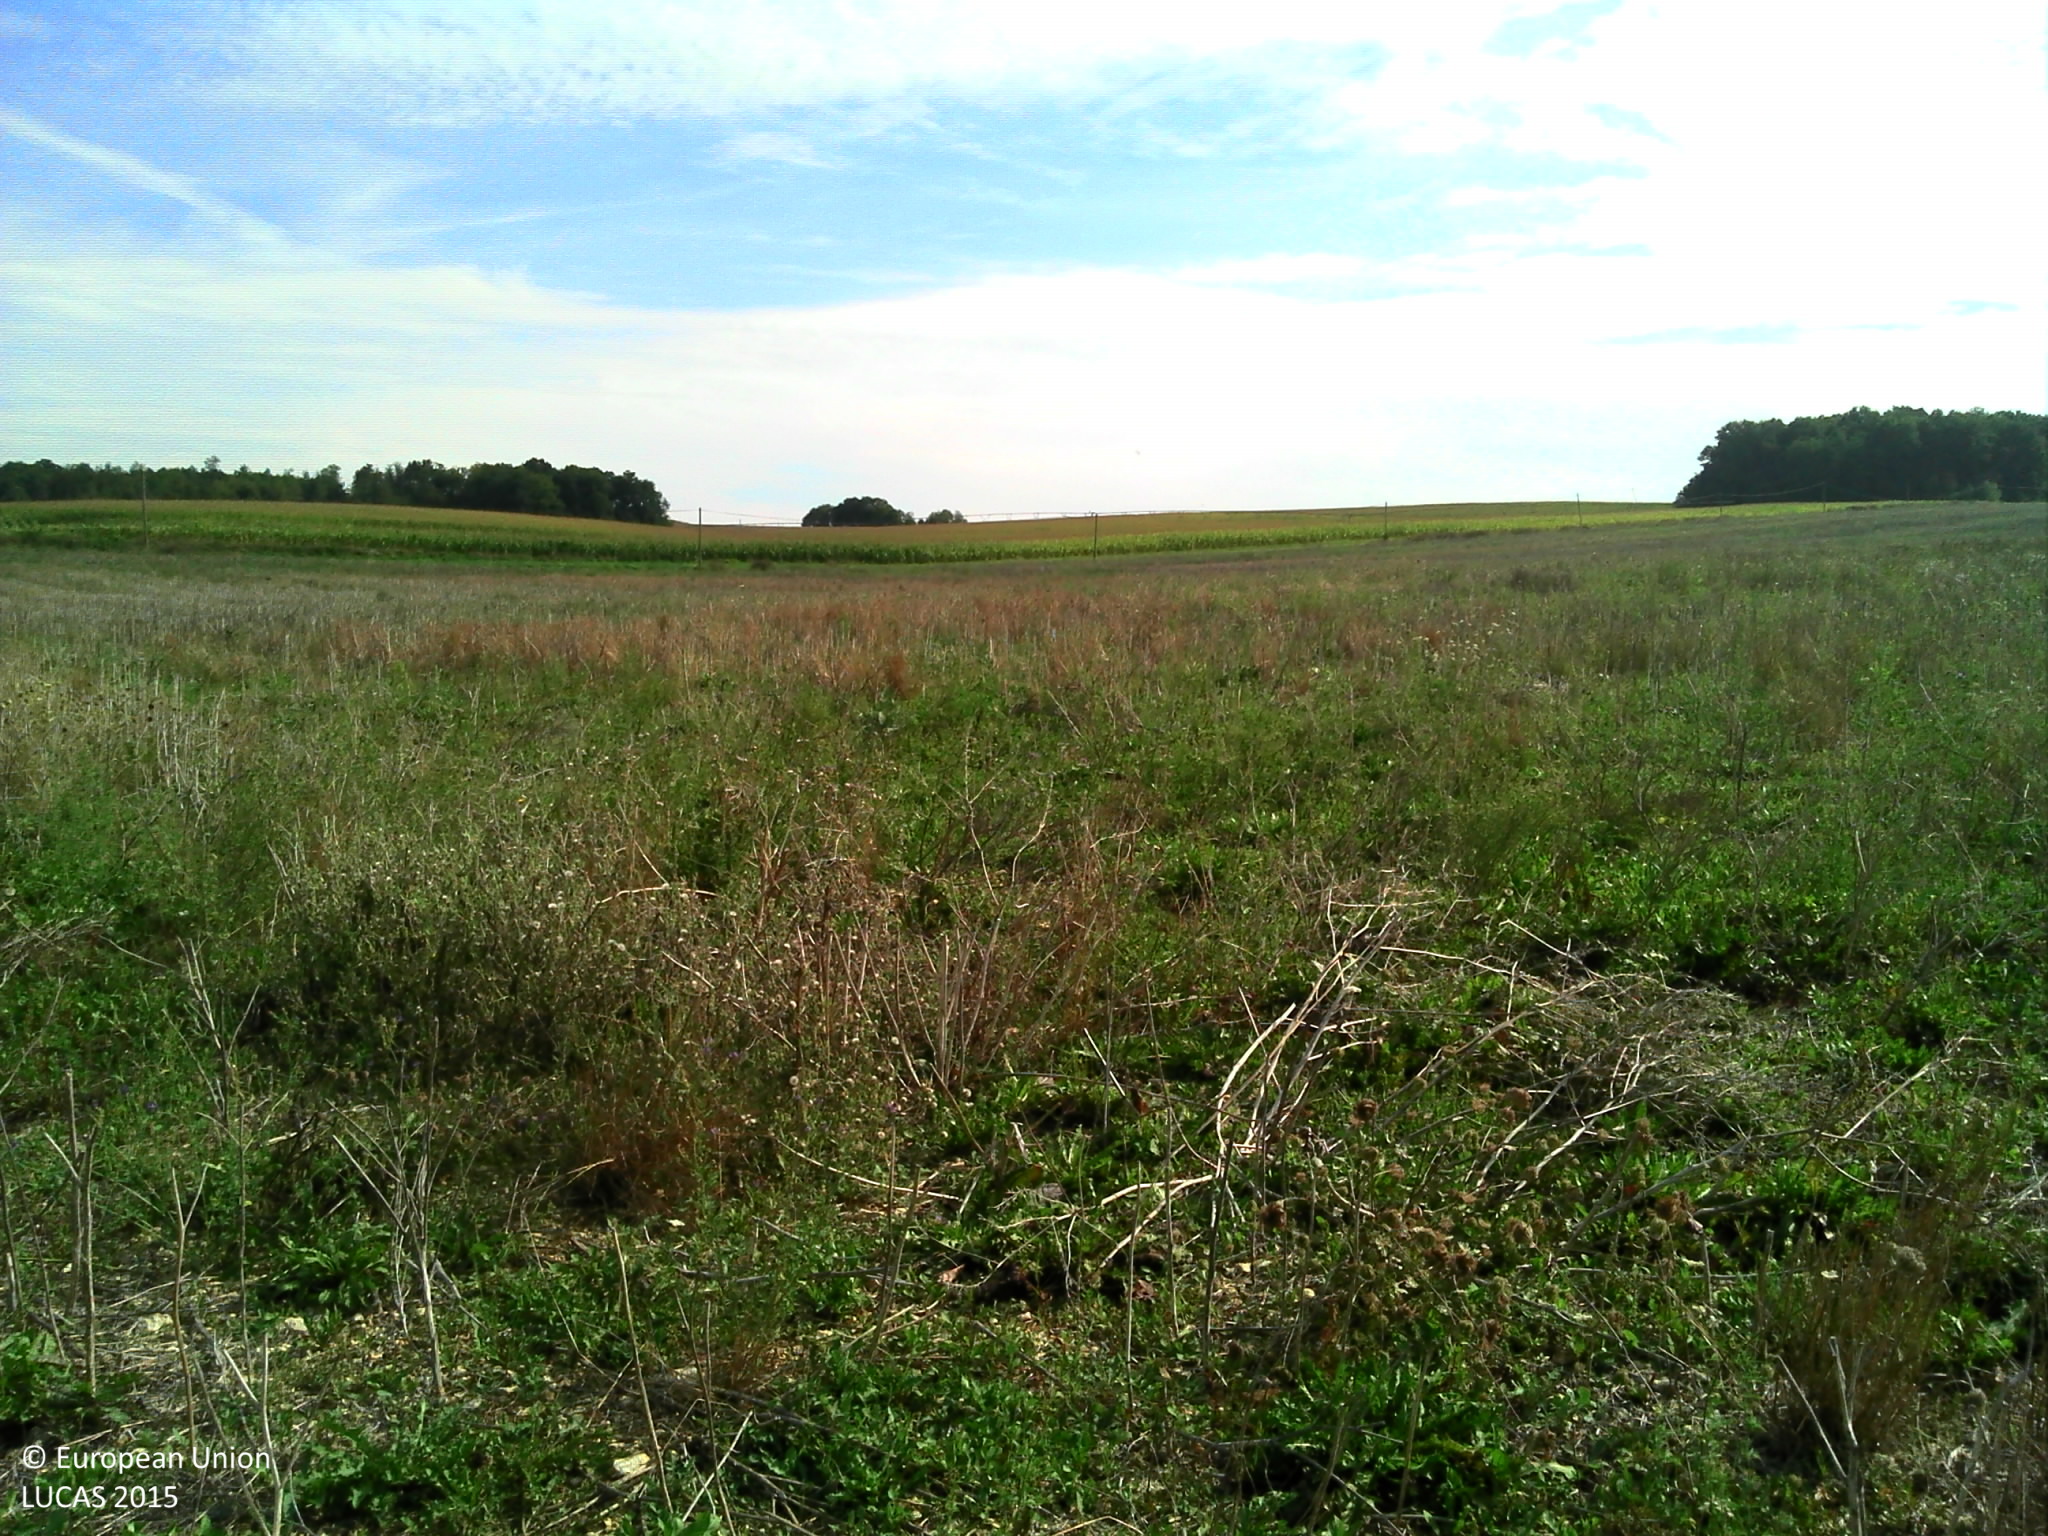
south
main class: Grassland
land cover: Spontaneously vegetated surfaces
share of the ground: 50 - 75 %
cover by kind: herbaceous plants 60 %, consolidated bare surface 40 %
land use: Agriculture (excluding fallow land and kitchen gardens)
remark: Harvested field
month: August
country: FR
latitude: 45.3989
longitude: 0.4701
